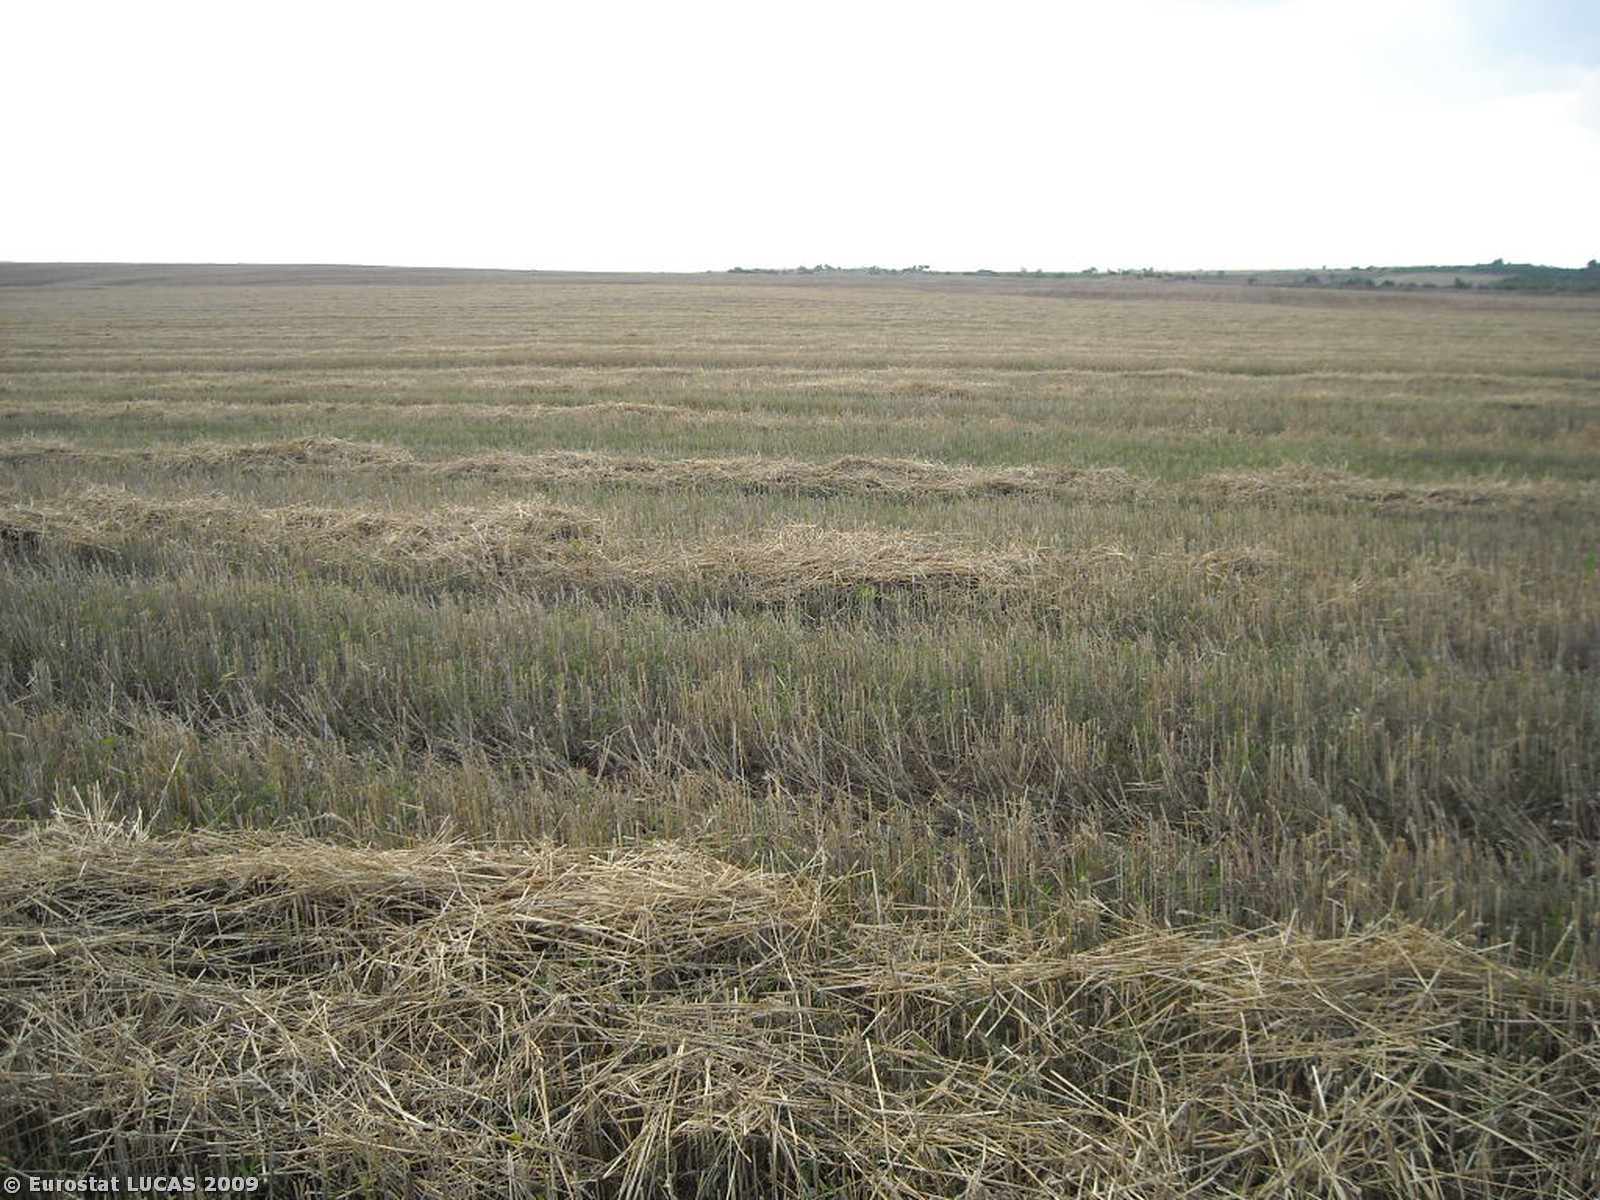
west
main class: Cropland
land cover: Durum wheat
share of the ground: < 10 %
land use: Agriculture (excluding fallow land and kitchen gardens)
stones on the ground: 10 - 25 %
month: July
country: IT
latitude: 41.0236
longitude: 16.3416
